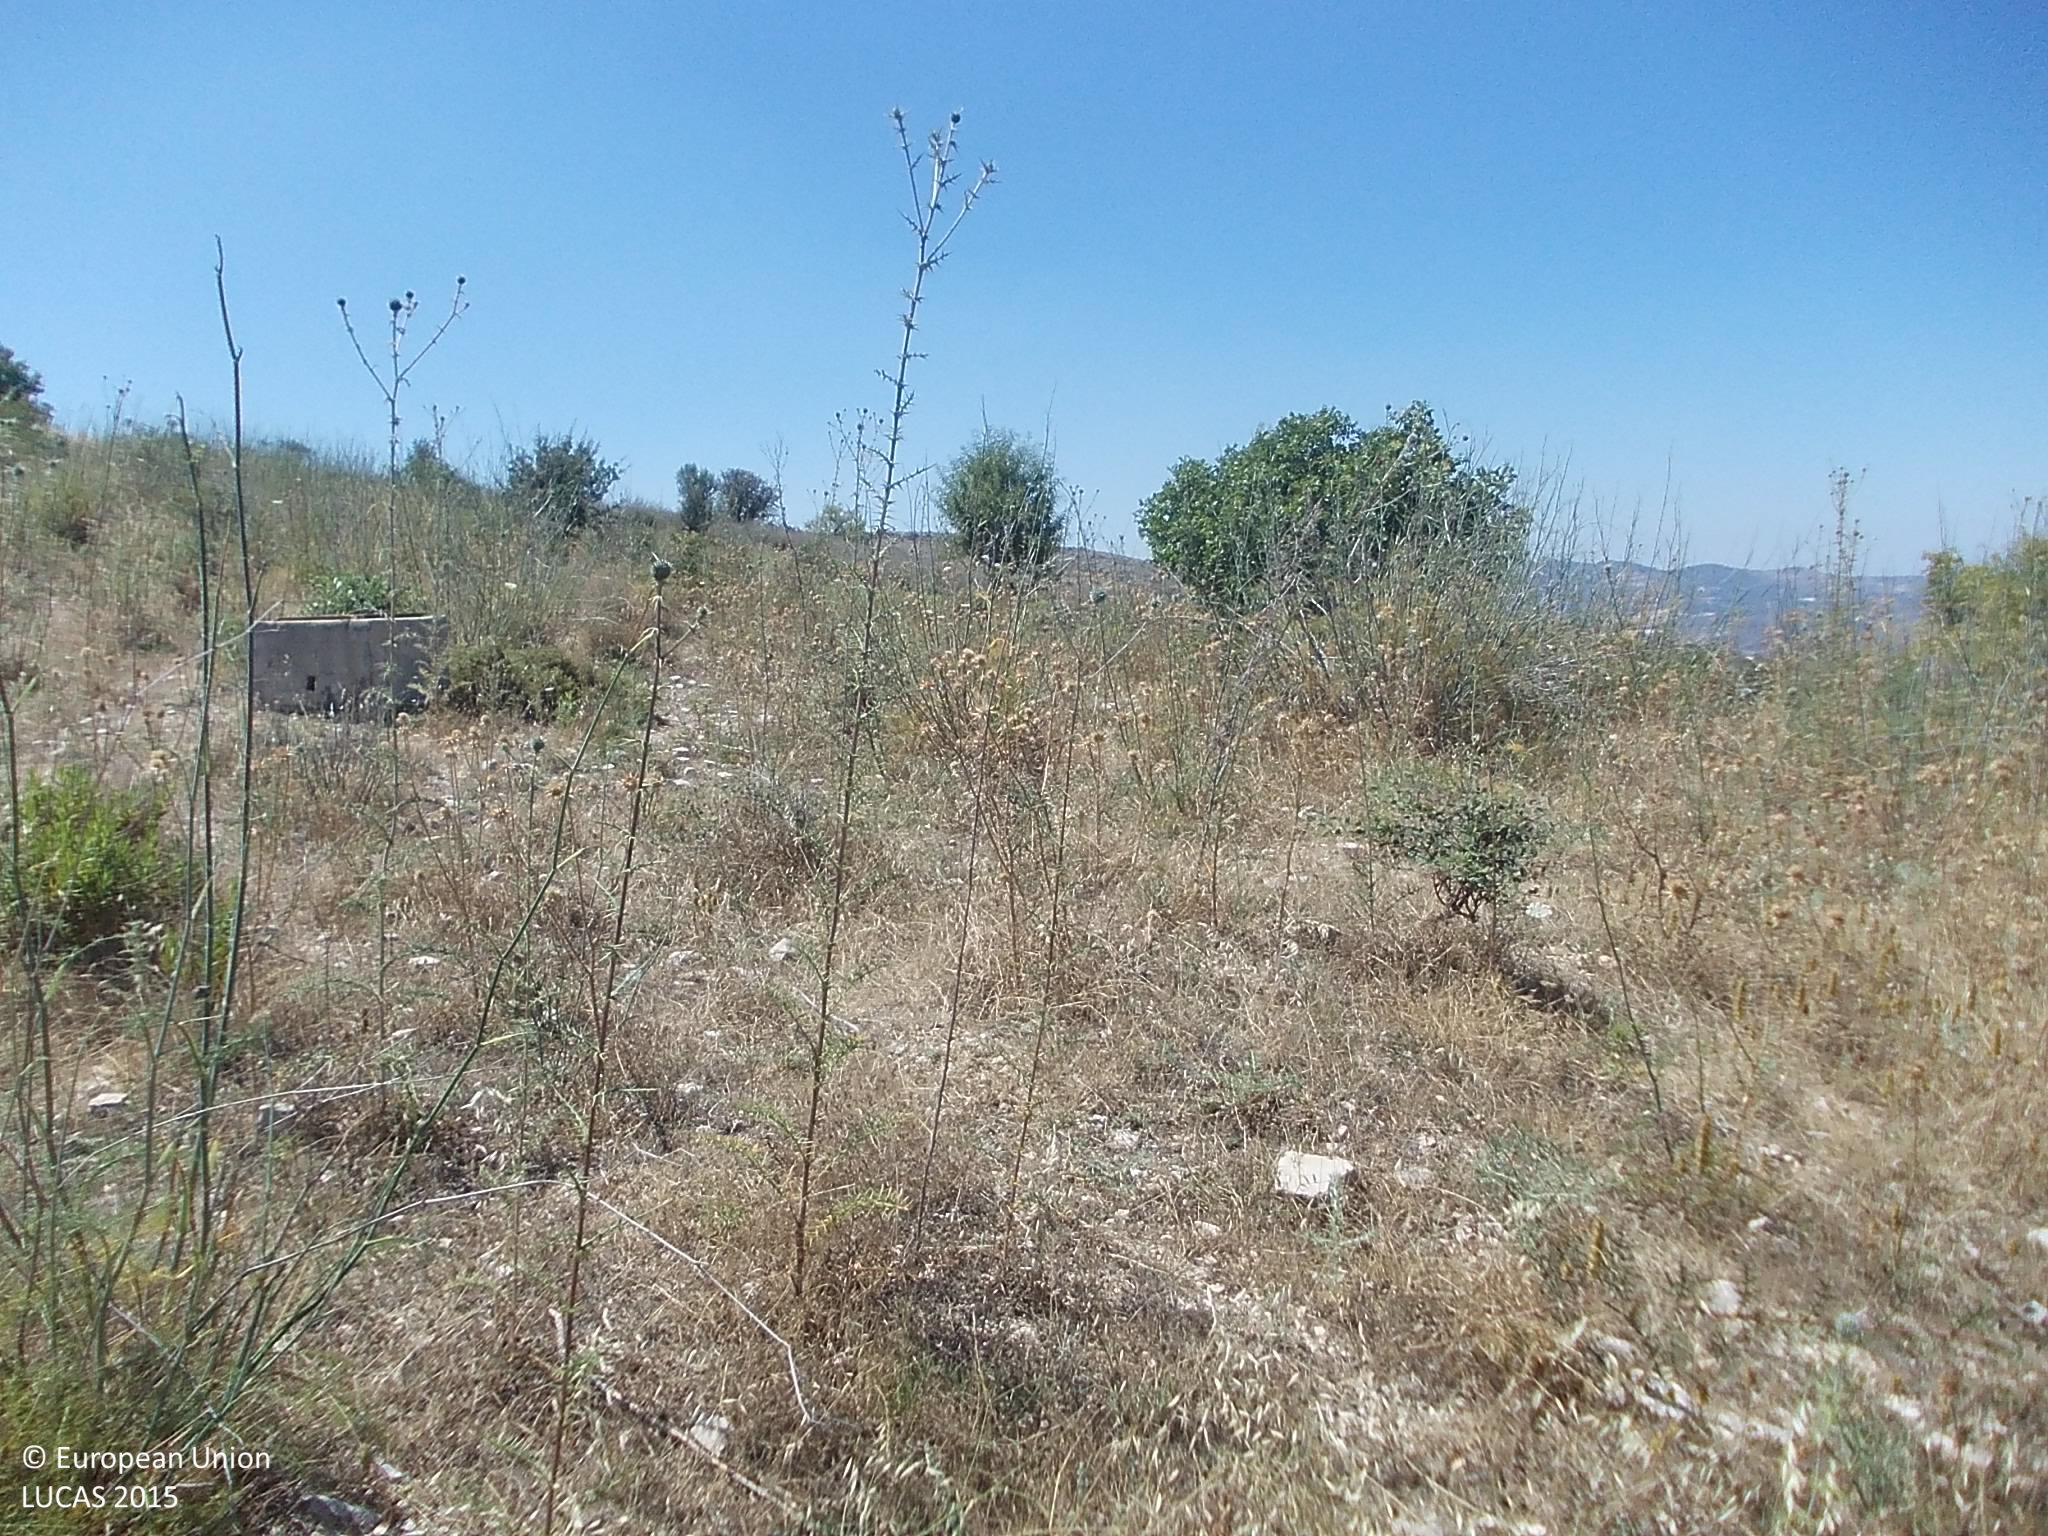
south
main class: Grassland
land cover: Grassland without tree/shrub cover
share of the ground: > 75 %
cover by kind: herbaceous plants 90 %, shrubs 5 %, unconsolidated bare surface 5 %
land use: Semi-natural and natural areas not in use
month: July
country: CY
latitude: 34.8411
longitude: 32.7408
